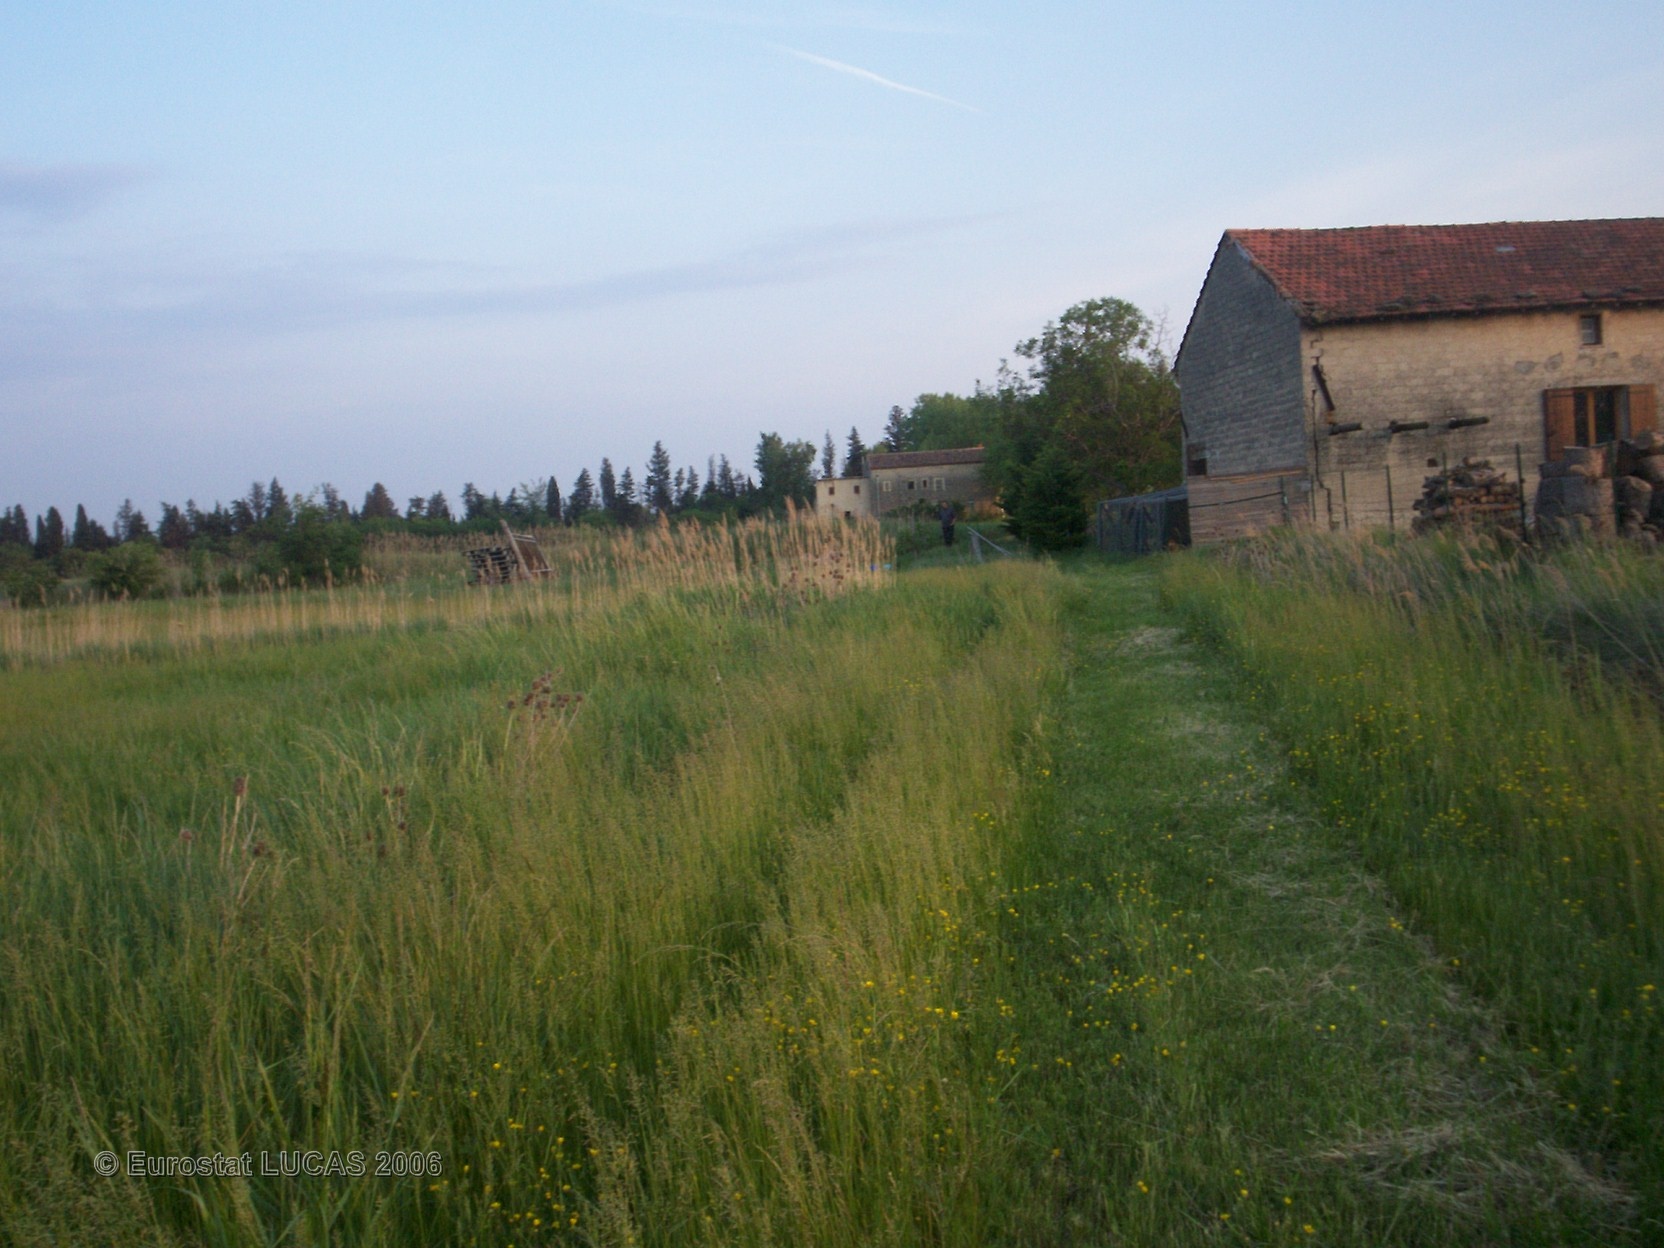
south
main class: Grassland
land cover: Grassland without tree/shrub cover
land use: Agriculture (excluding fallow land and kitchen gardens)
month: May
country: FR
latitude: 44.0471
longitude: 4.9536
